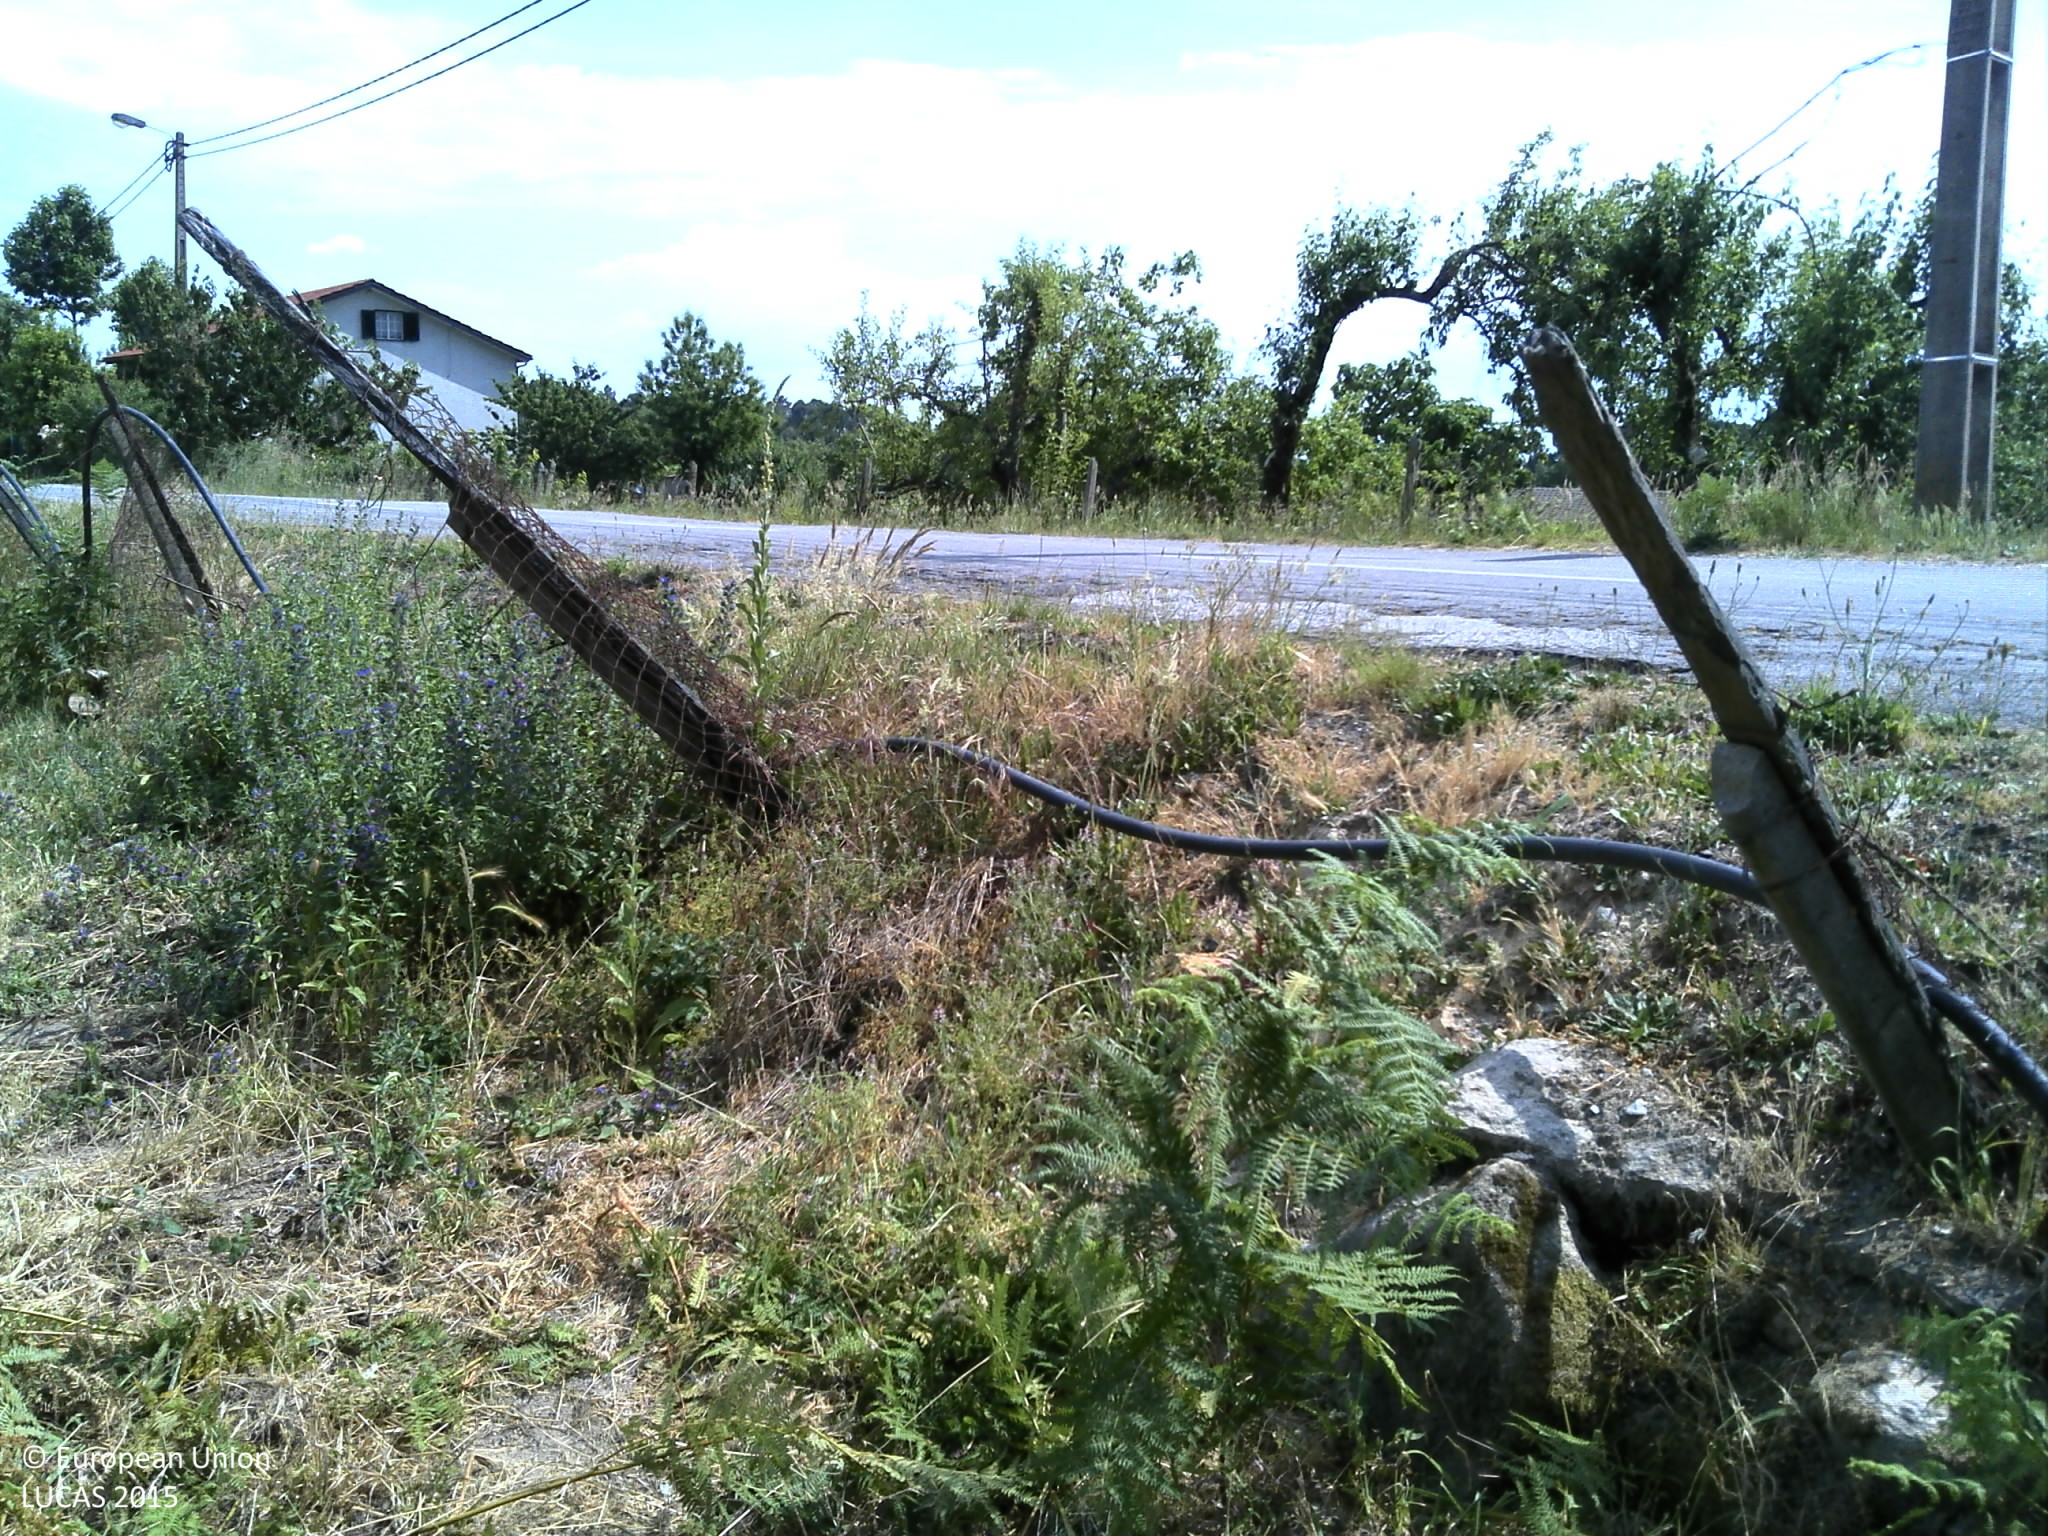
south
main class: Grassland
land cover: Grassland without tree/shrub cover
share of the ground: > 75 %
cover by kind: herbaceous plants 95 %, shrubs 5 %
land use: Agriculture (excluding fallow land and kitchen gardens)
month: June
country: PT
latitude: 41.3323
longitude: -7.6329
